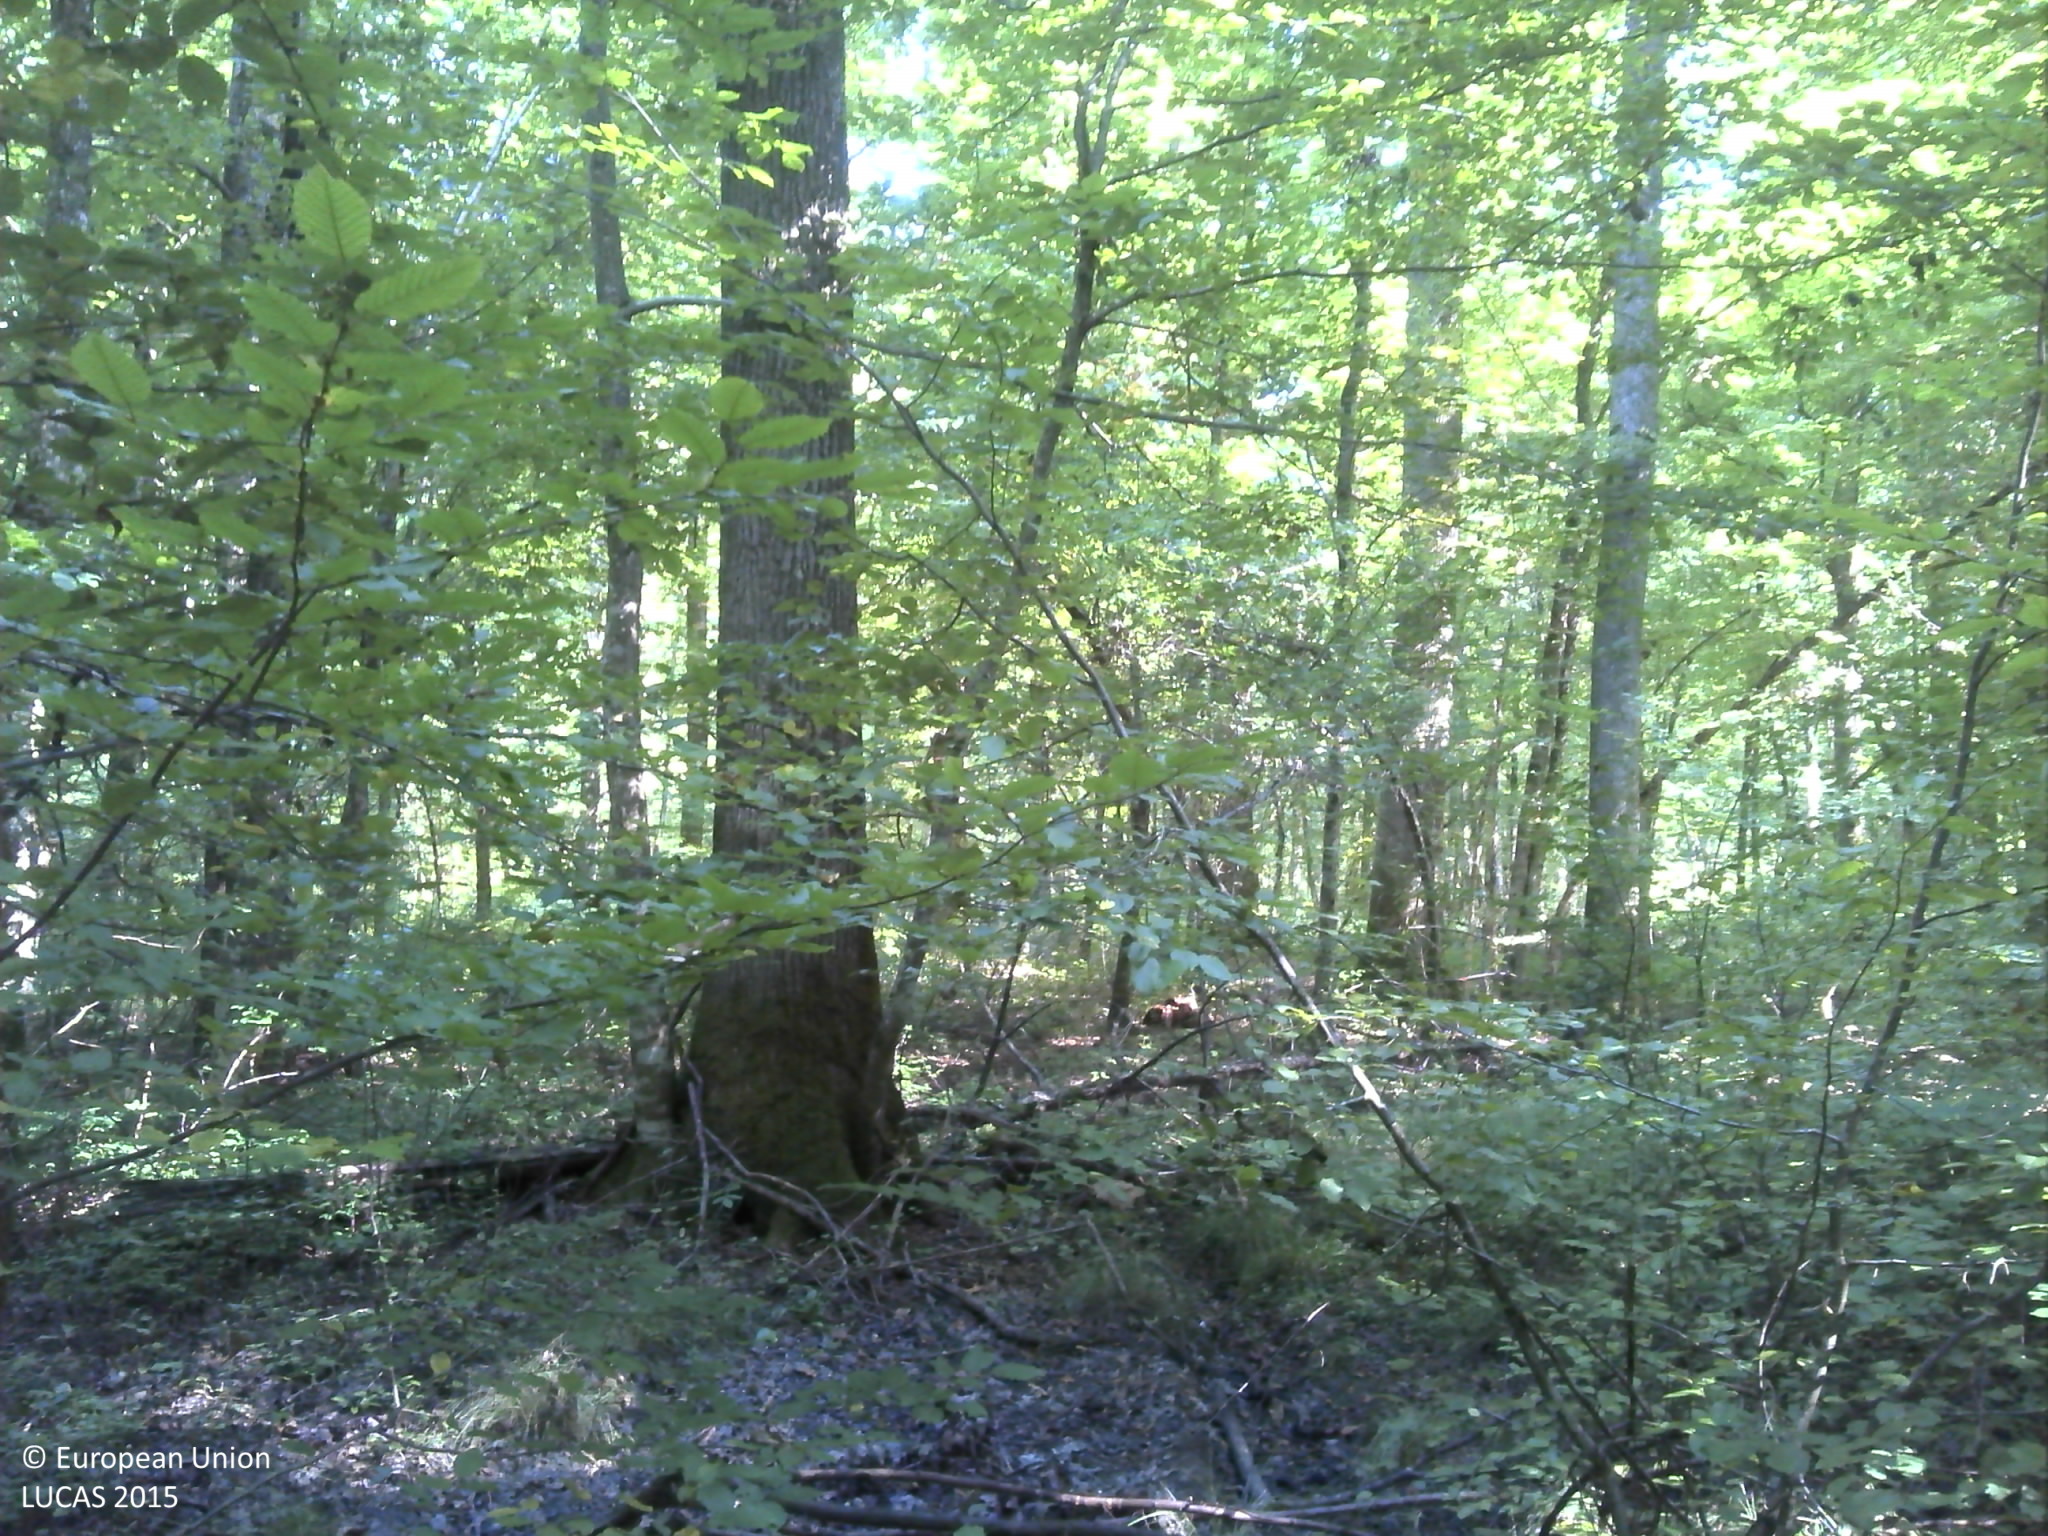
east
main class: Woodland
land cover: Broadleaved woodland
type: acidophilous oak and oak-birch forest
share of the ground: > 75 %
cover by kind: broadleaved forest trees 100 %
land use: Forestry
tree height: > 5 m
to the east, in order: Broadleaved woodland; Tracks; Broadleaved woodland
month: September
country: HR
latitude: 45.4996
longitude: 16.2556
